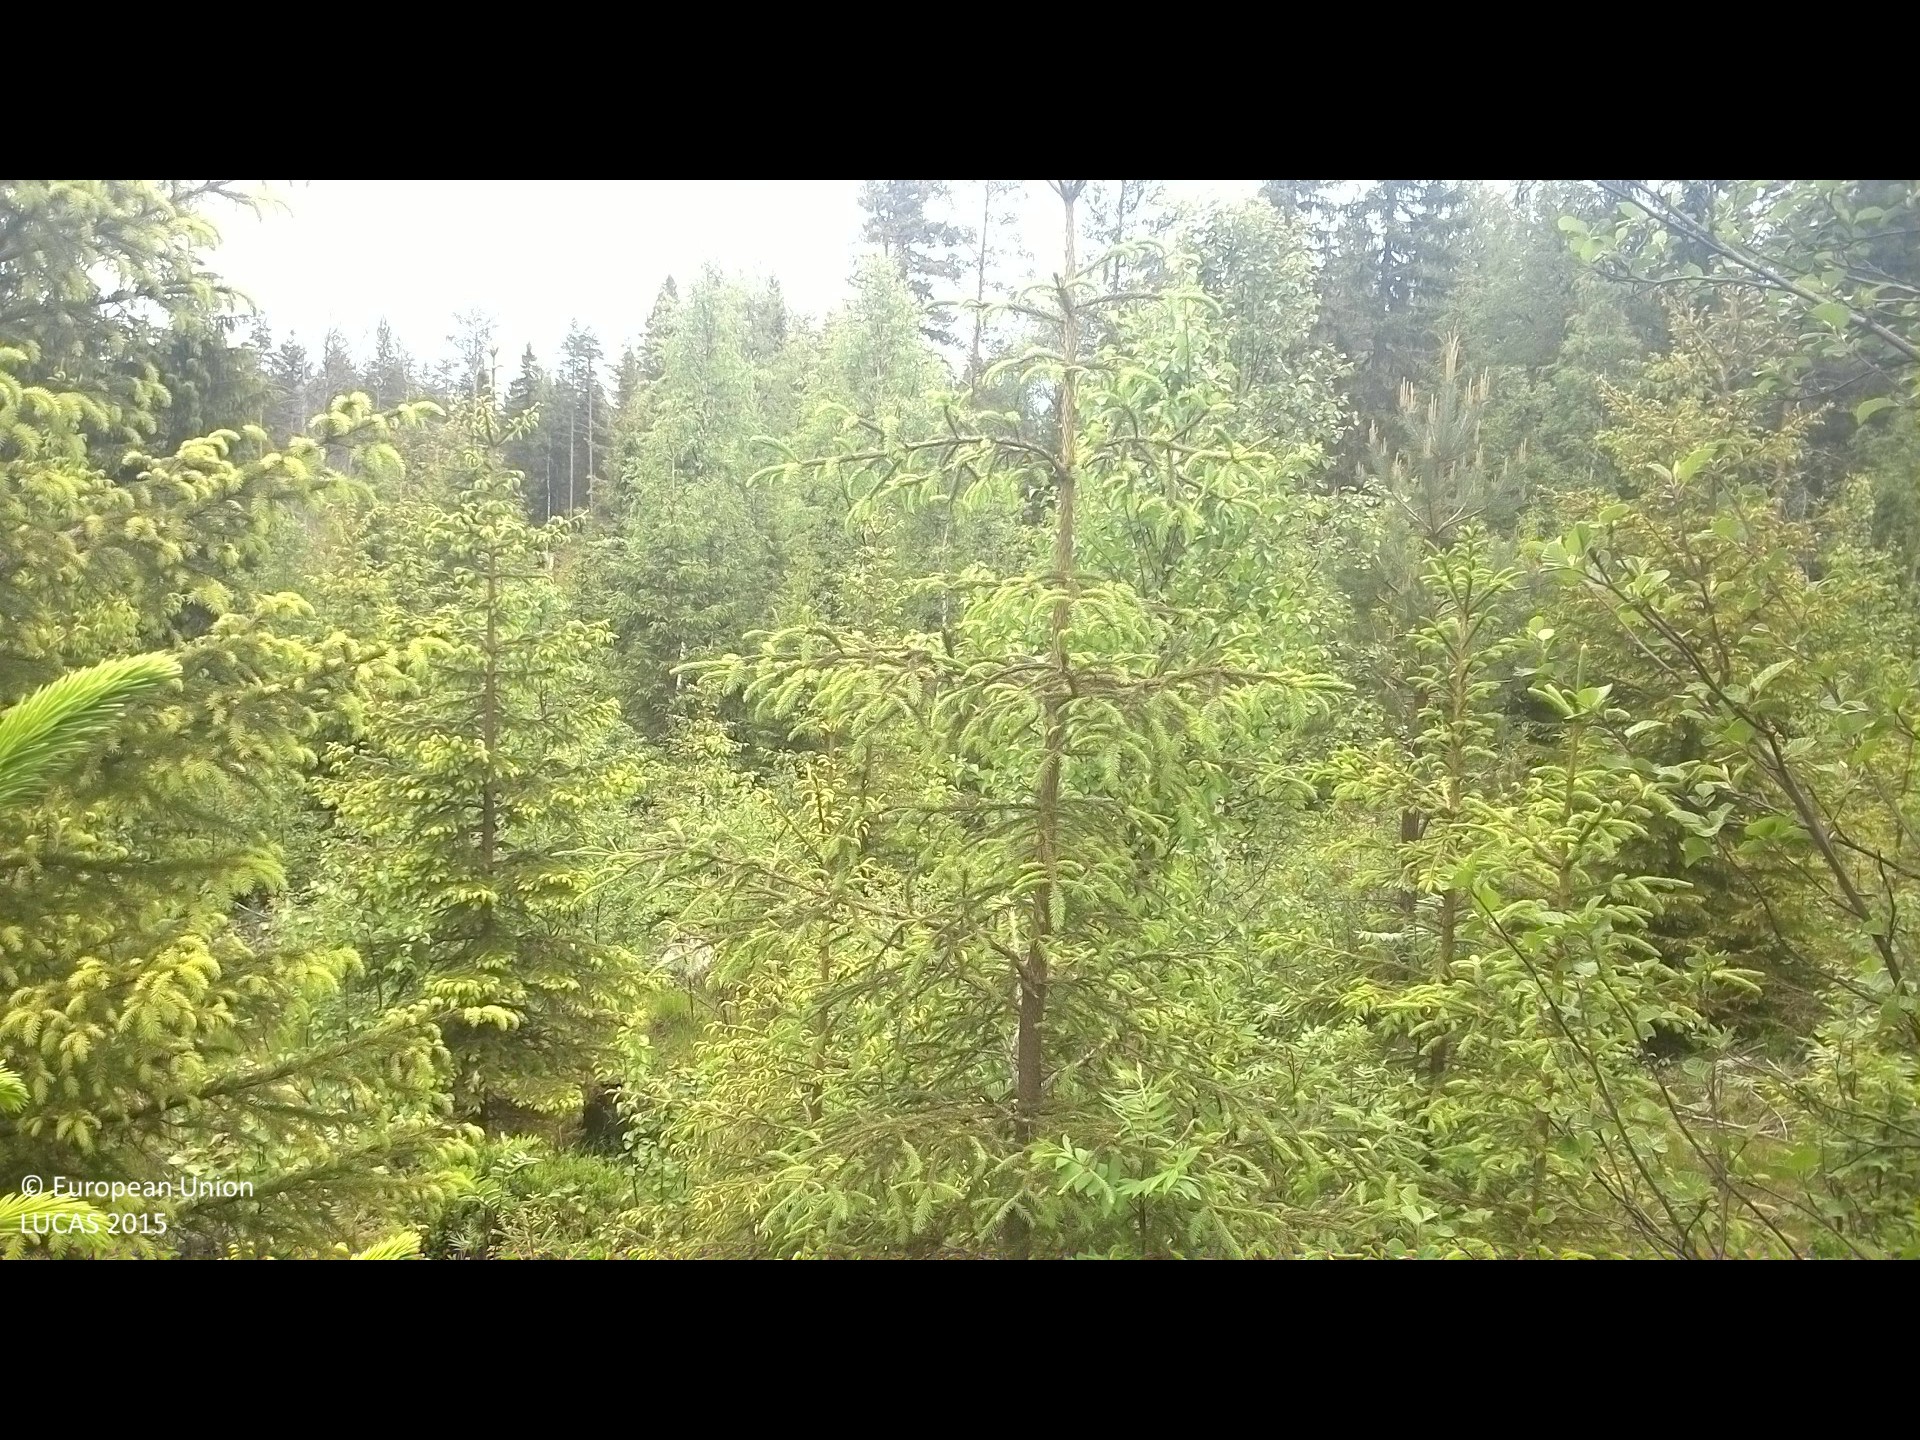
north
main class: Woodland
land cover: Spruce dominated mixed woodland
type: boreal forest
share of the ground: 25 - 50 %
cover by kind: coniferous forest trees 30 %, shrubs 30 %, lichens and mosses 25 %, broadleaved forest trees 15 %
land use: Forestry
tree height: < 5 m
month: June
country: SE
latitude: 61.9917
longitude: 16.7202
